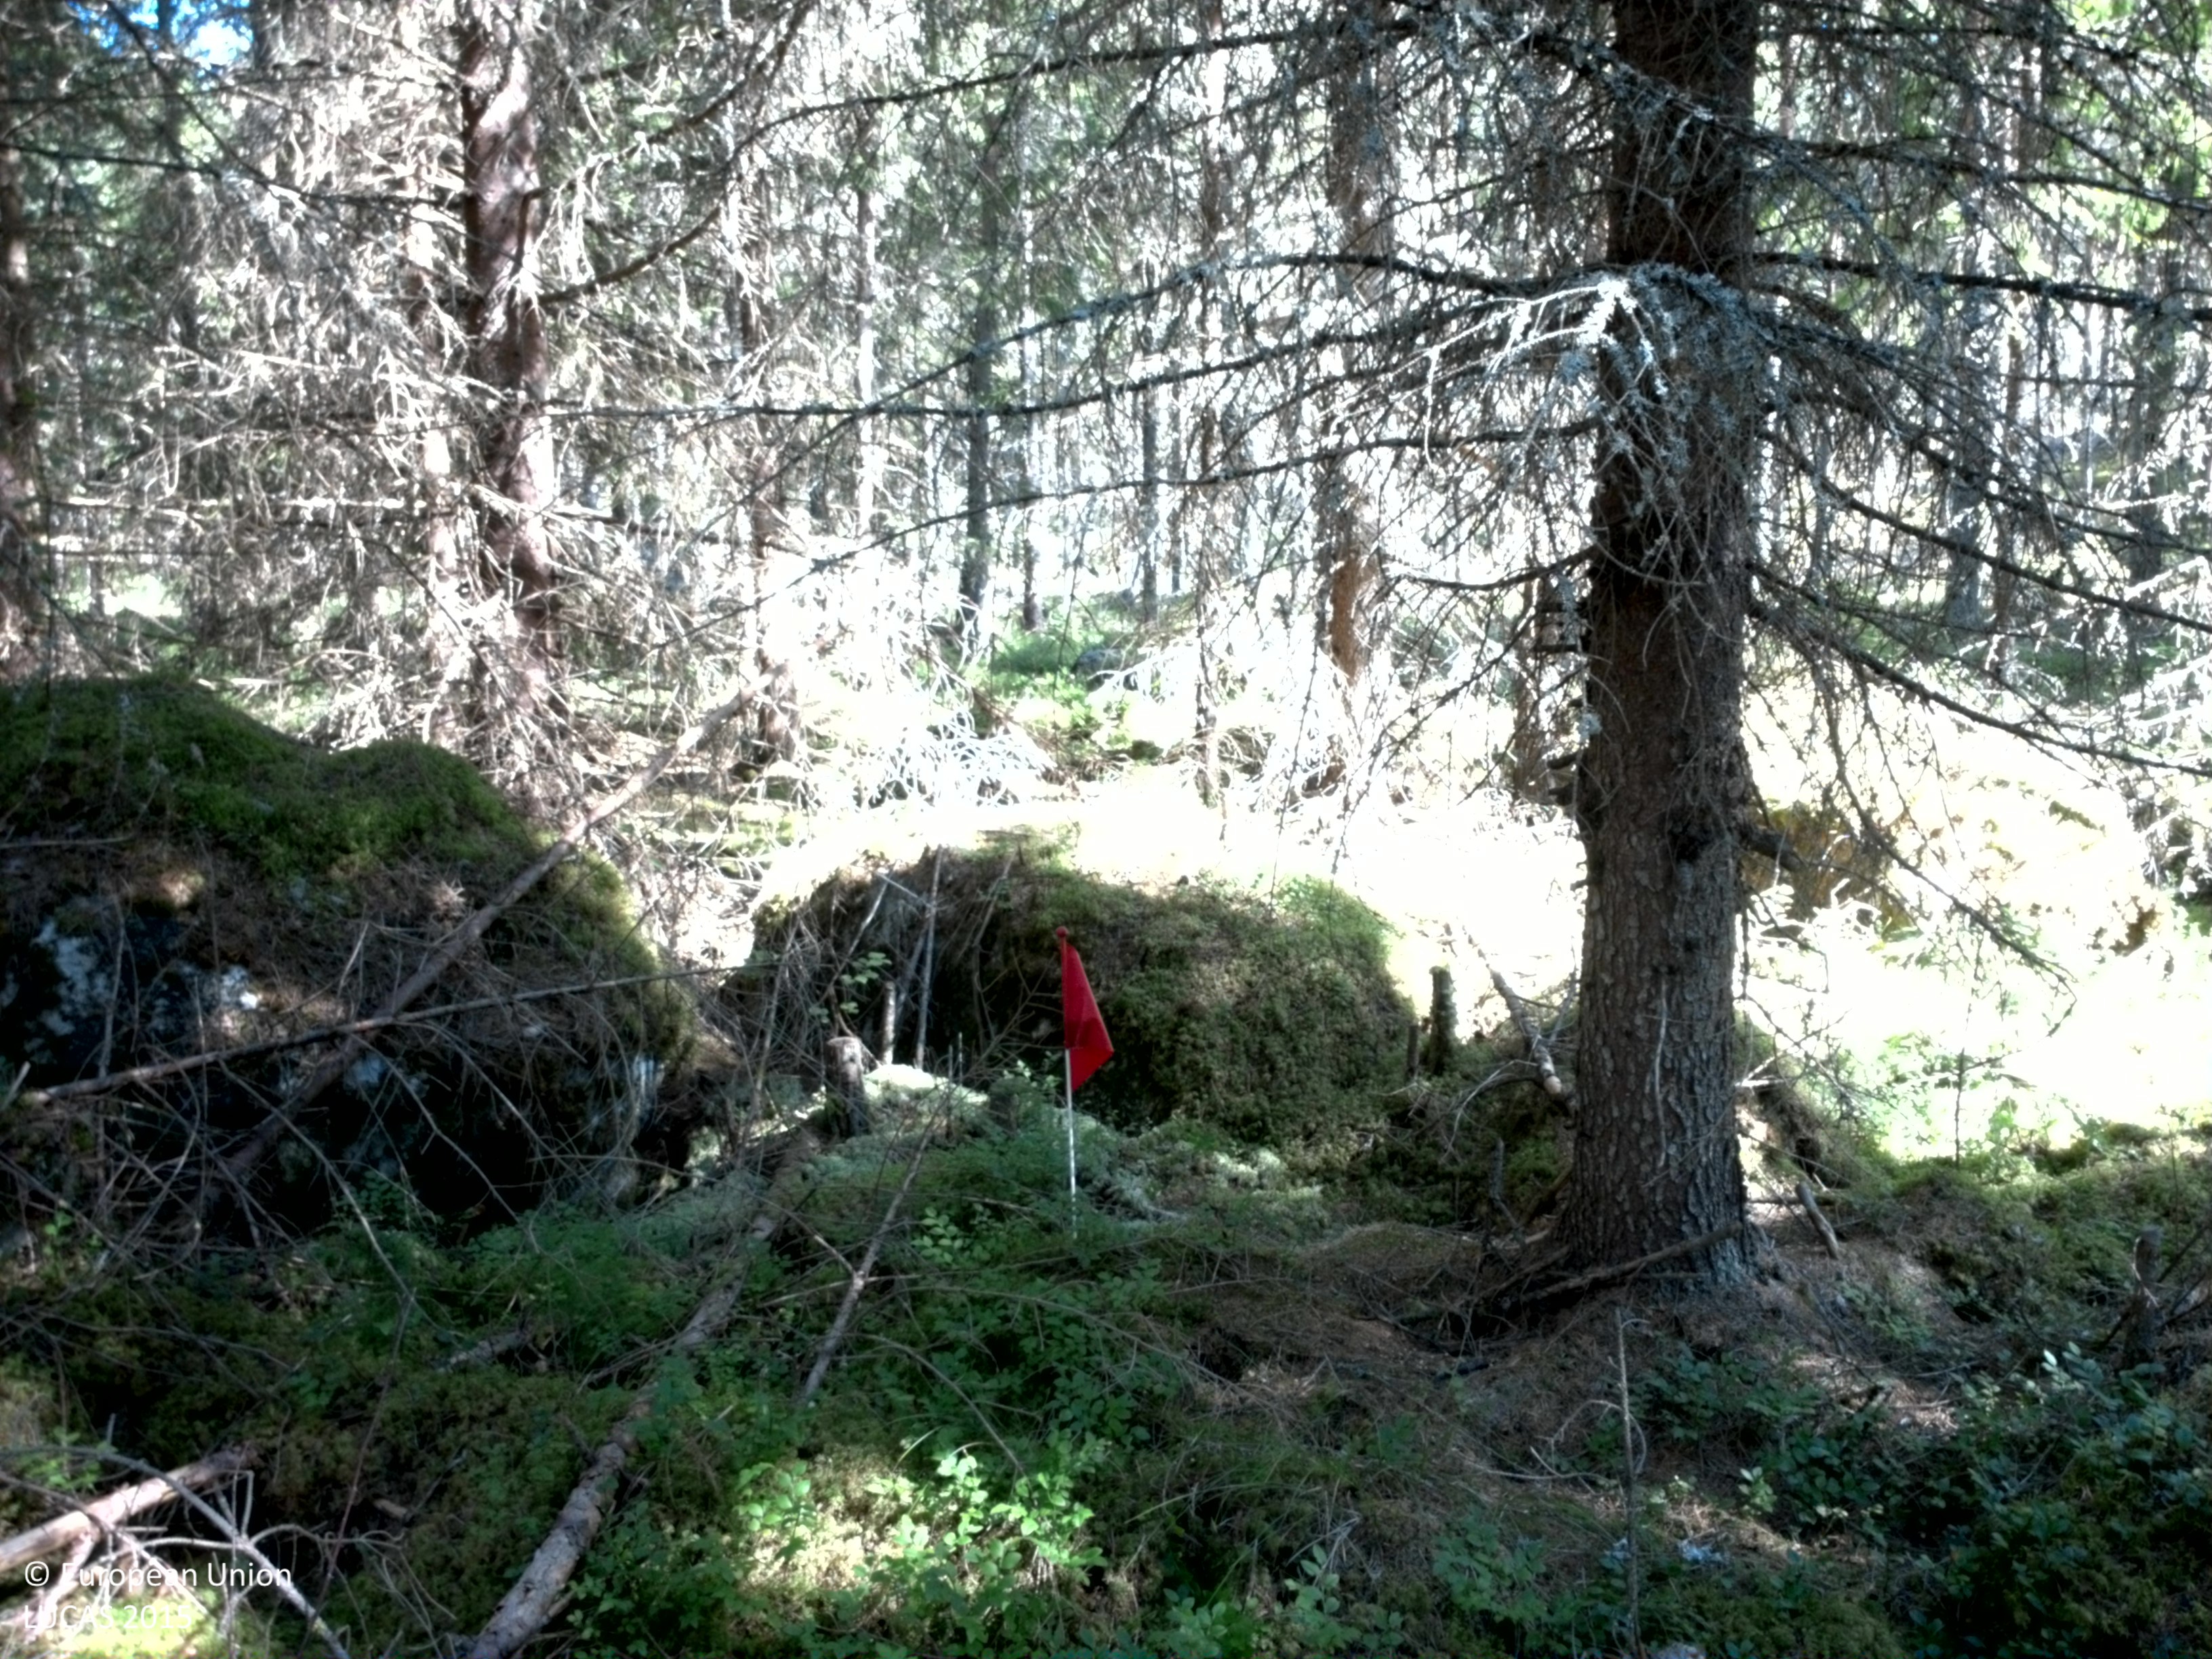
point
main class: Woodland
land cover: Spruce dominated coniferous woodland
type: boreal forest
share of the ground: 50 - 75 %
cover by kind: coniferous forest trees 60 %, lichens and mosses 30 %, shrubs 10 %
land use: Forestry
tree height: > 5 m
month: August
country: SE
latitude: 60.0824
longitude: 13.5316
